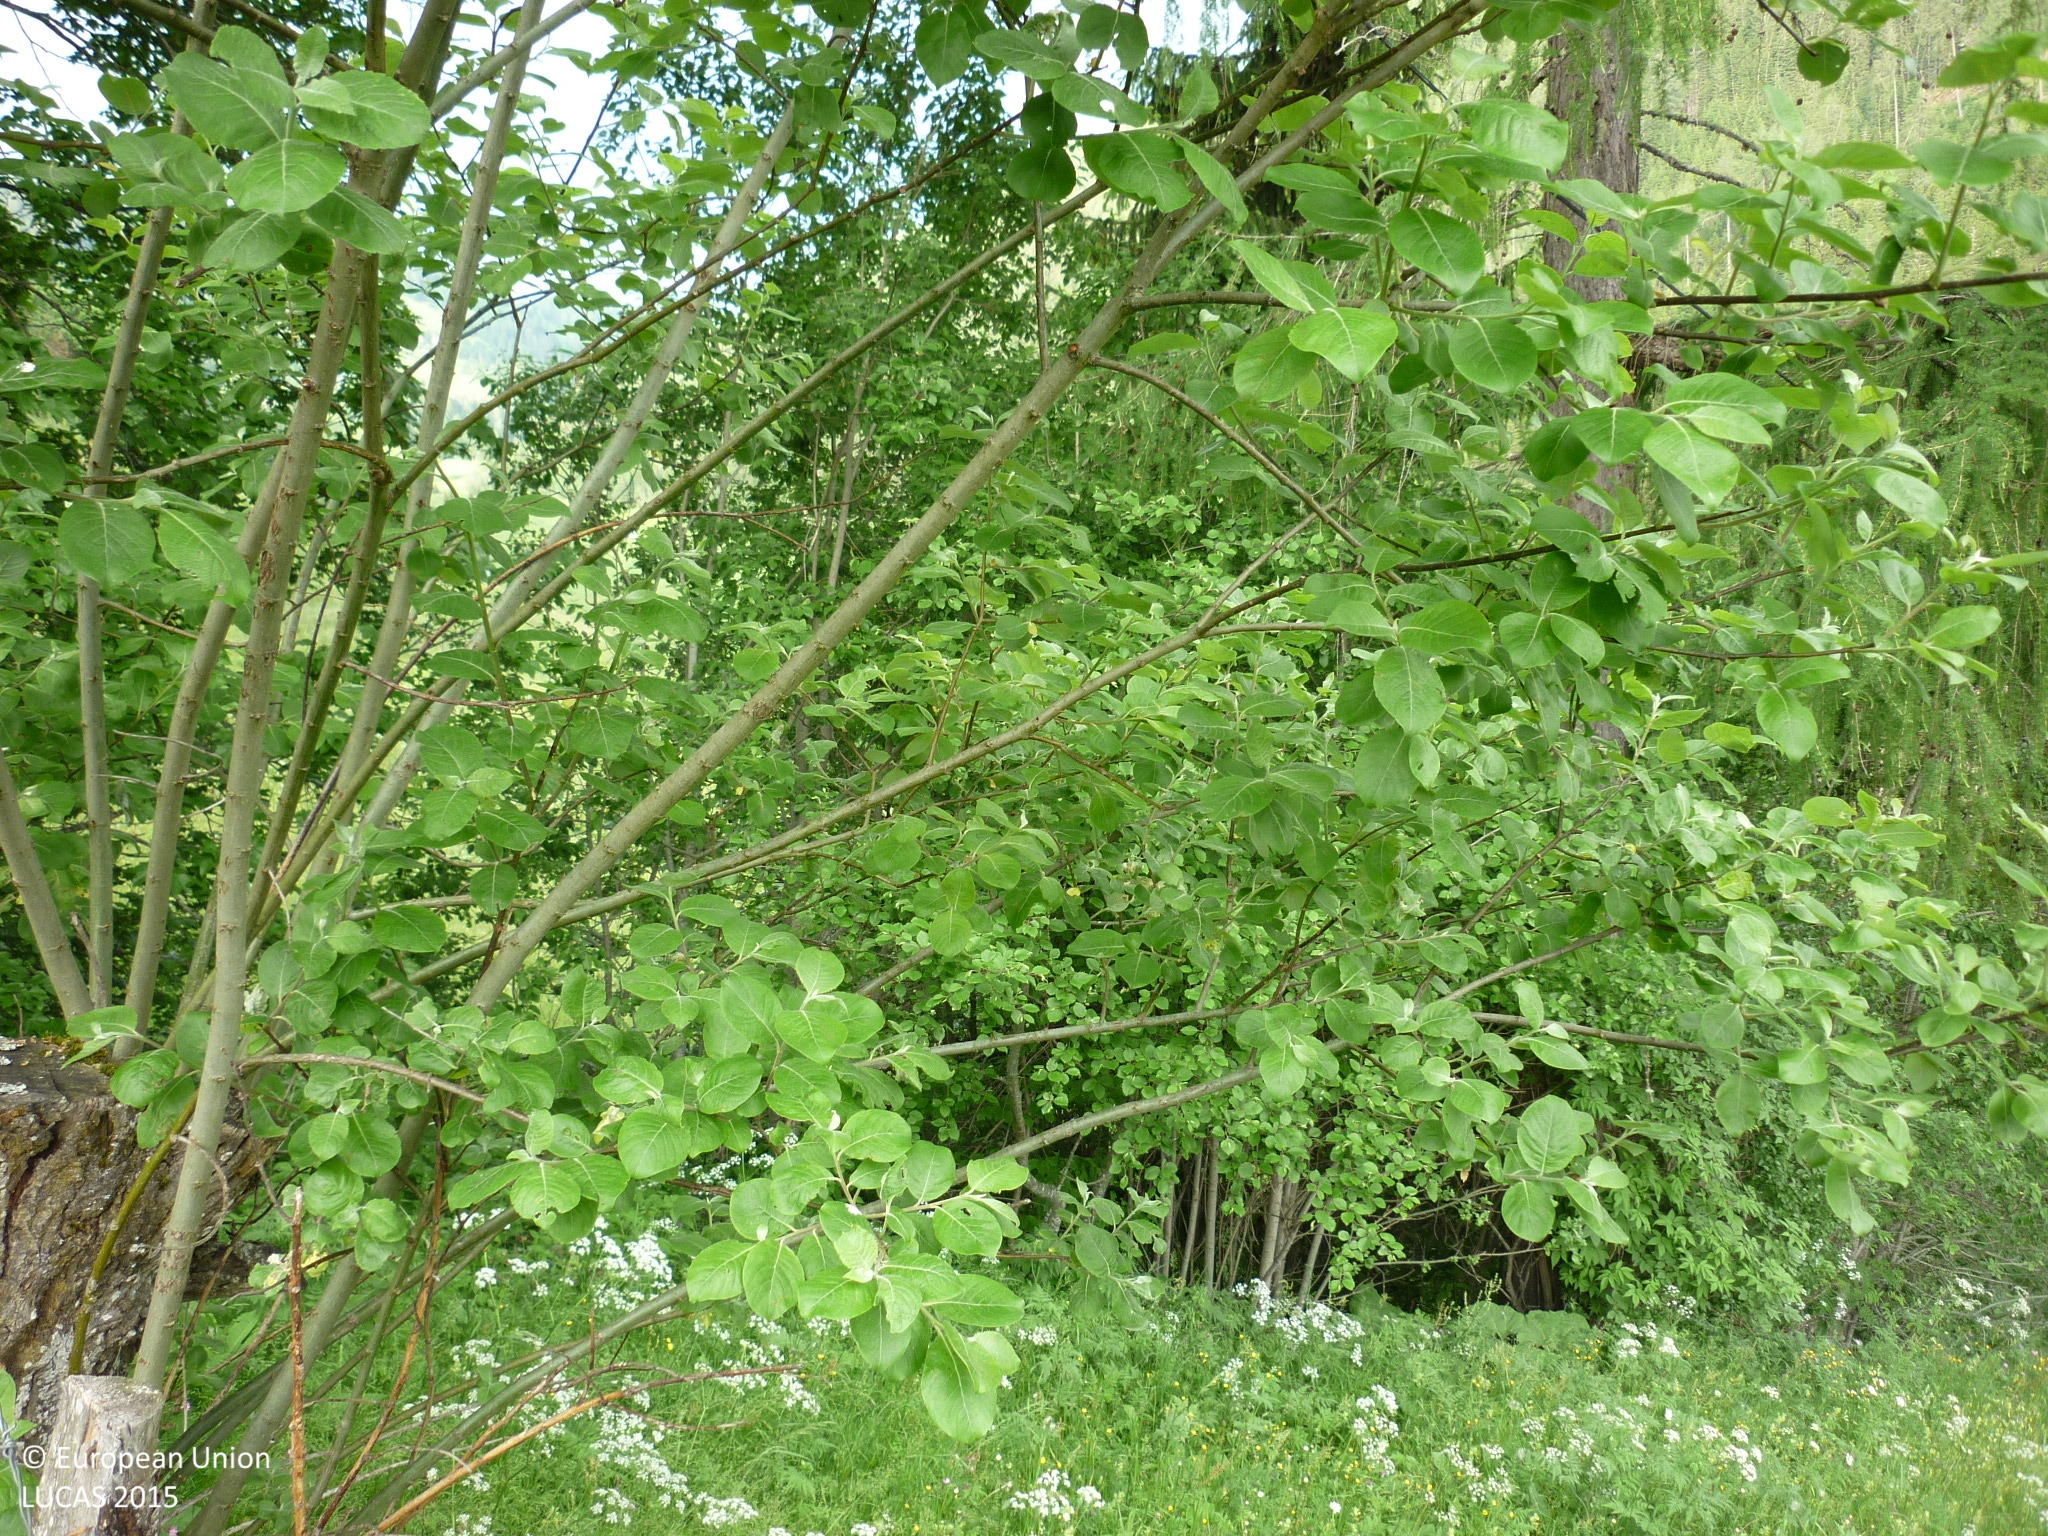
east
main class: Grassland
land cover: Grassland without tree/shrub cover
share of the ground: > 75 %
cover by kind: herbaceous plants 100 %
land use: Agriculture (excluding fallow land and kitchen gardens)
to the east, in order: Grassland without tree/shrub cover; Electric lines; Grassland without tree/shrub cover; Broadleaved woodland; Rivers and streams; Broadleaved woodland; Grassland without tree/shrub cover; Fences; Spontaneously vegetated surfaces; Spruce dominated mixed woodland; Inland fresh running water; Broadleaved woodland
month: June
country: AT
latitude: 47.1610
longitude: 13.9686
